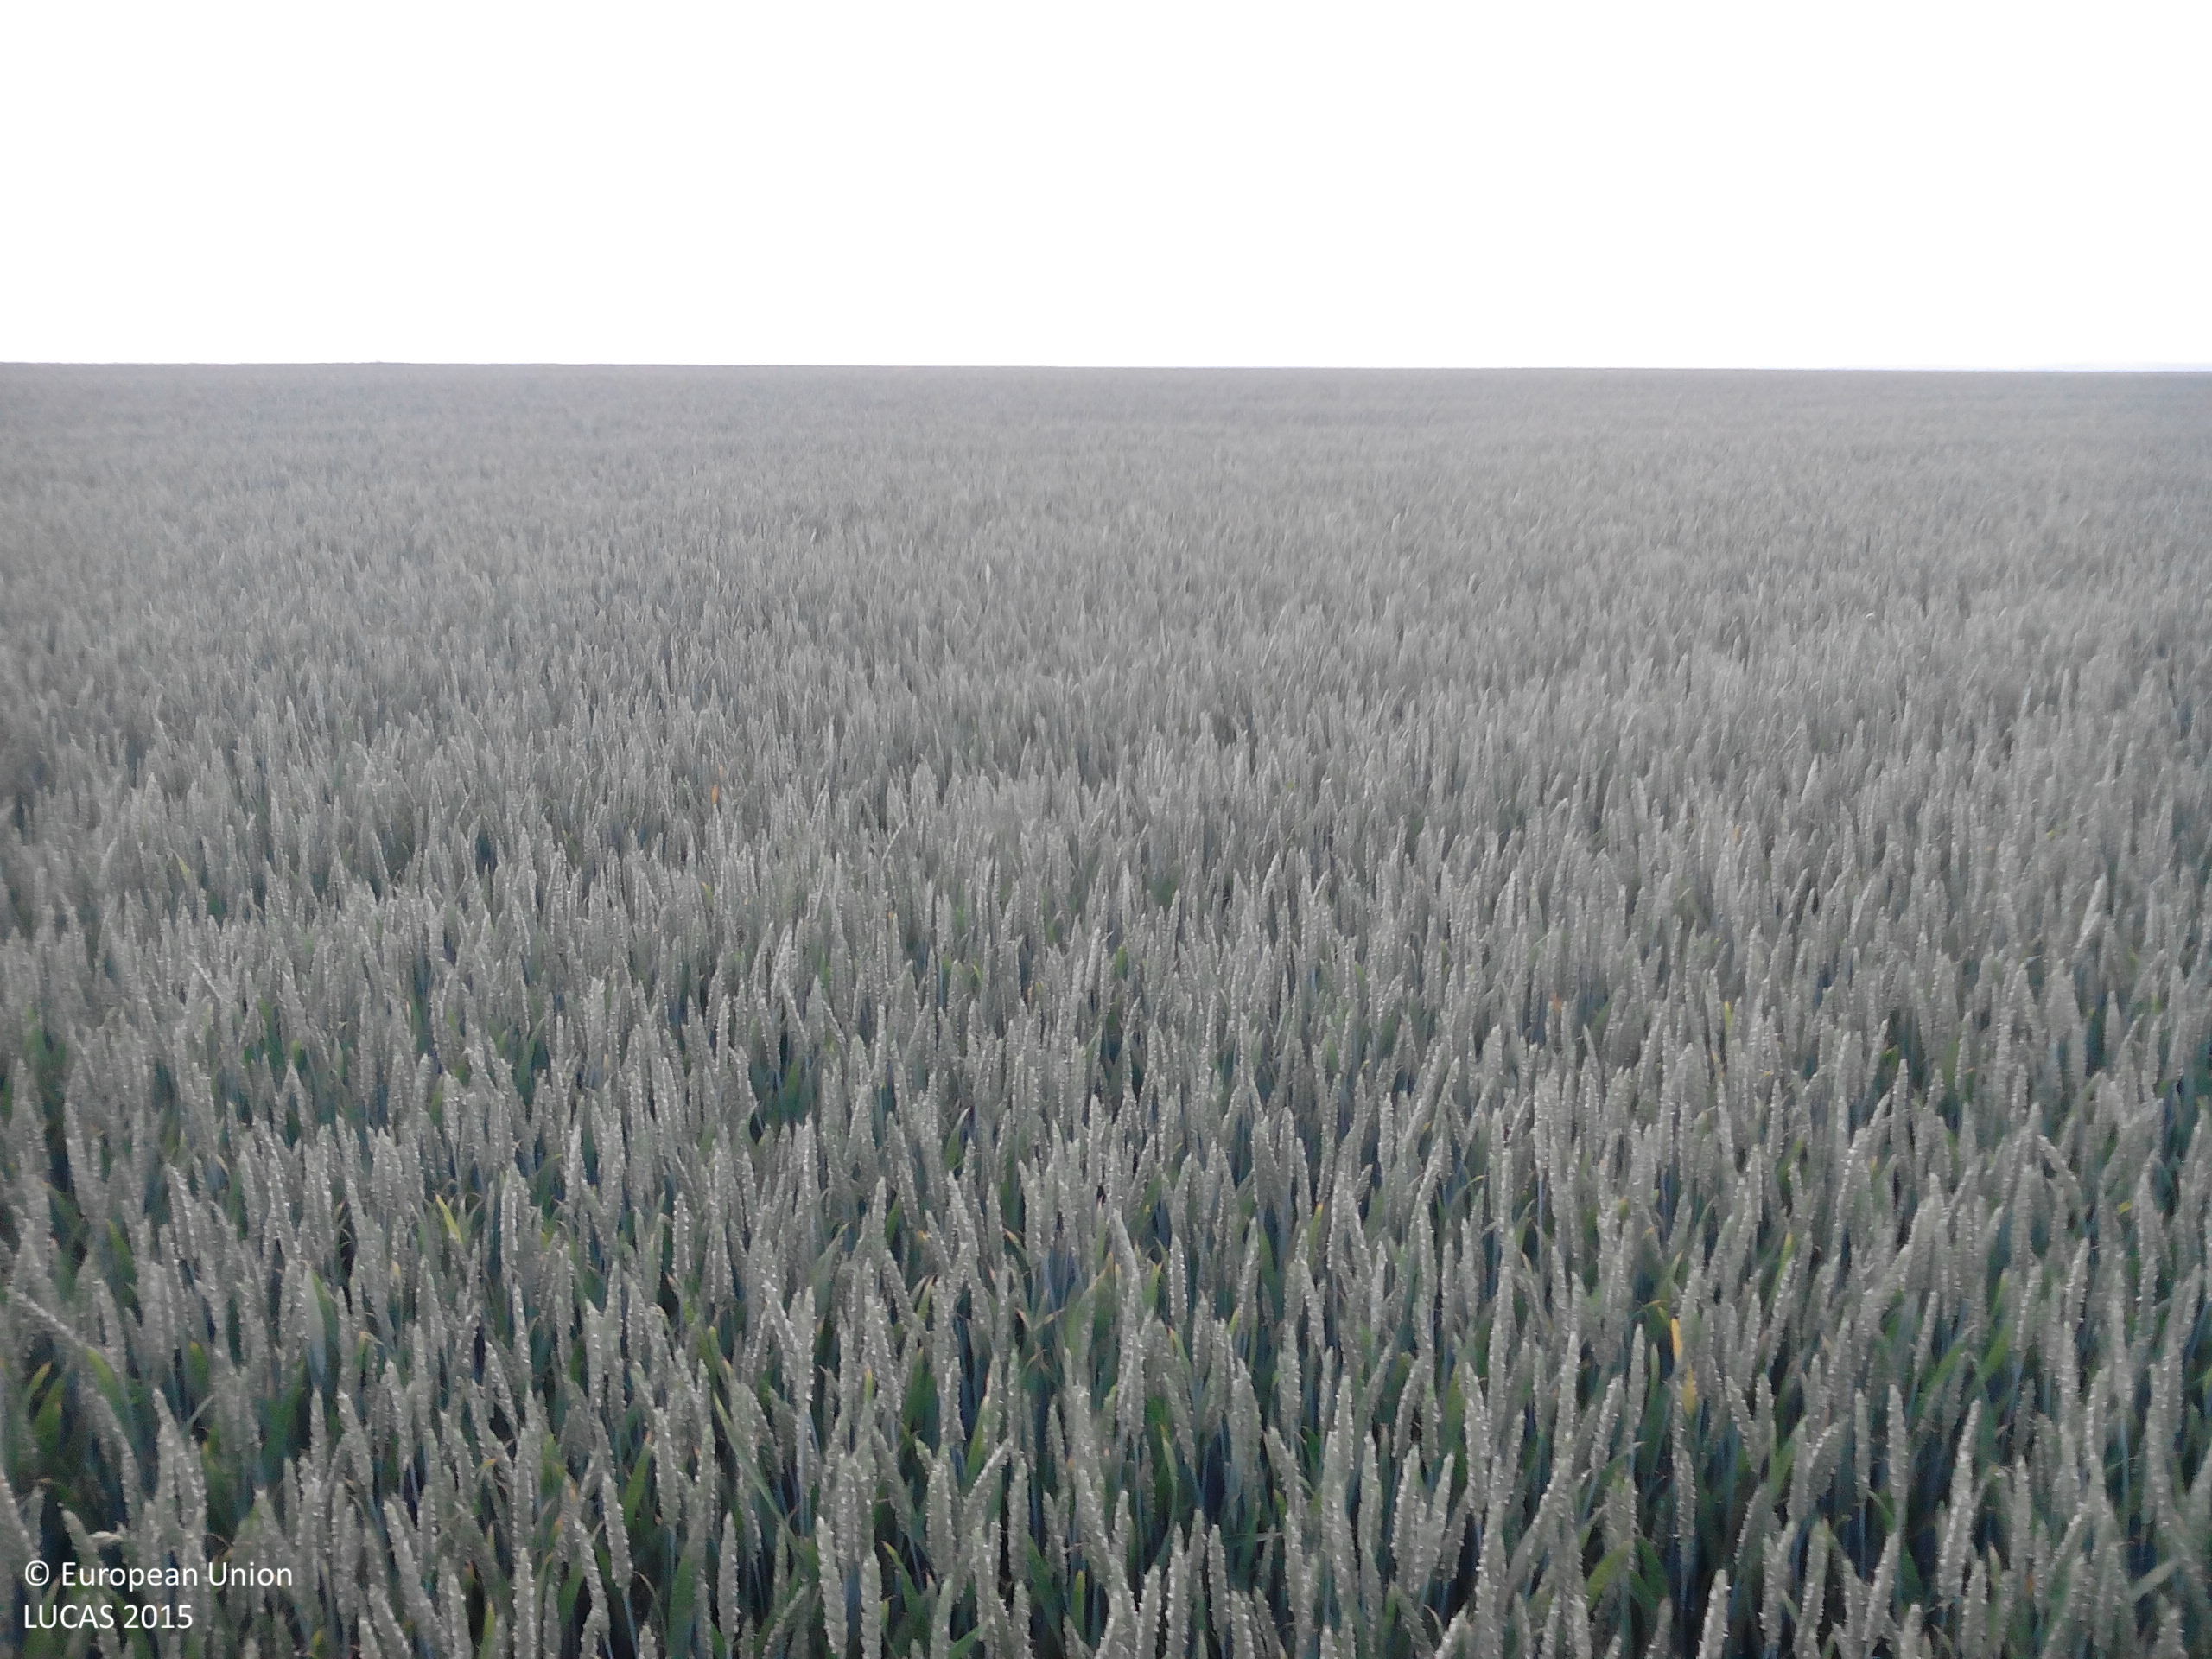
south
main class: Cropland
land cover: Common wheat
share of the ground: > 75 %
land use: Agriculture (excluding fallow land and kitchen gardens)
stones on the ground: < 10 %
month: May
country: BG
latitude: 43.6001
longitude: 24.2422
